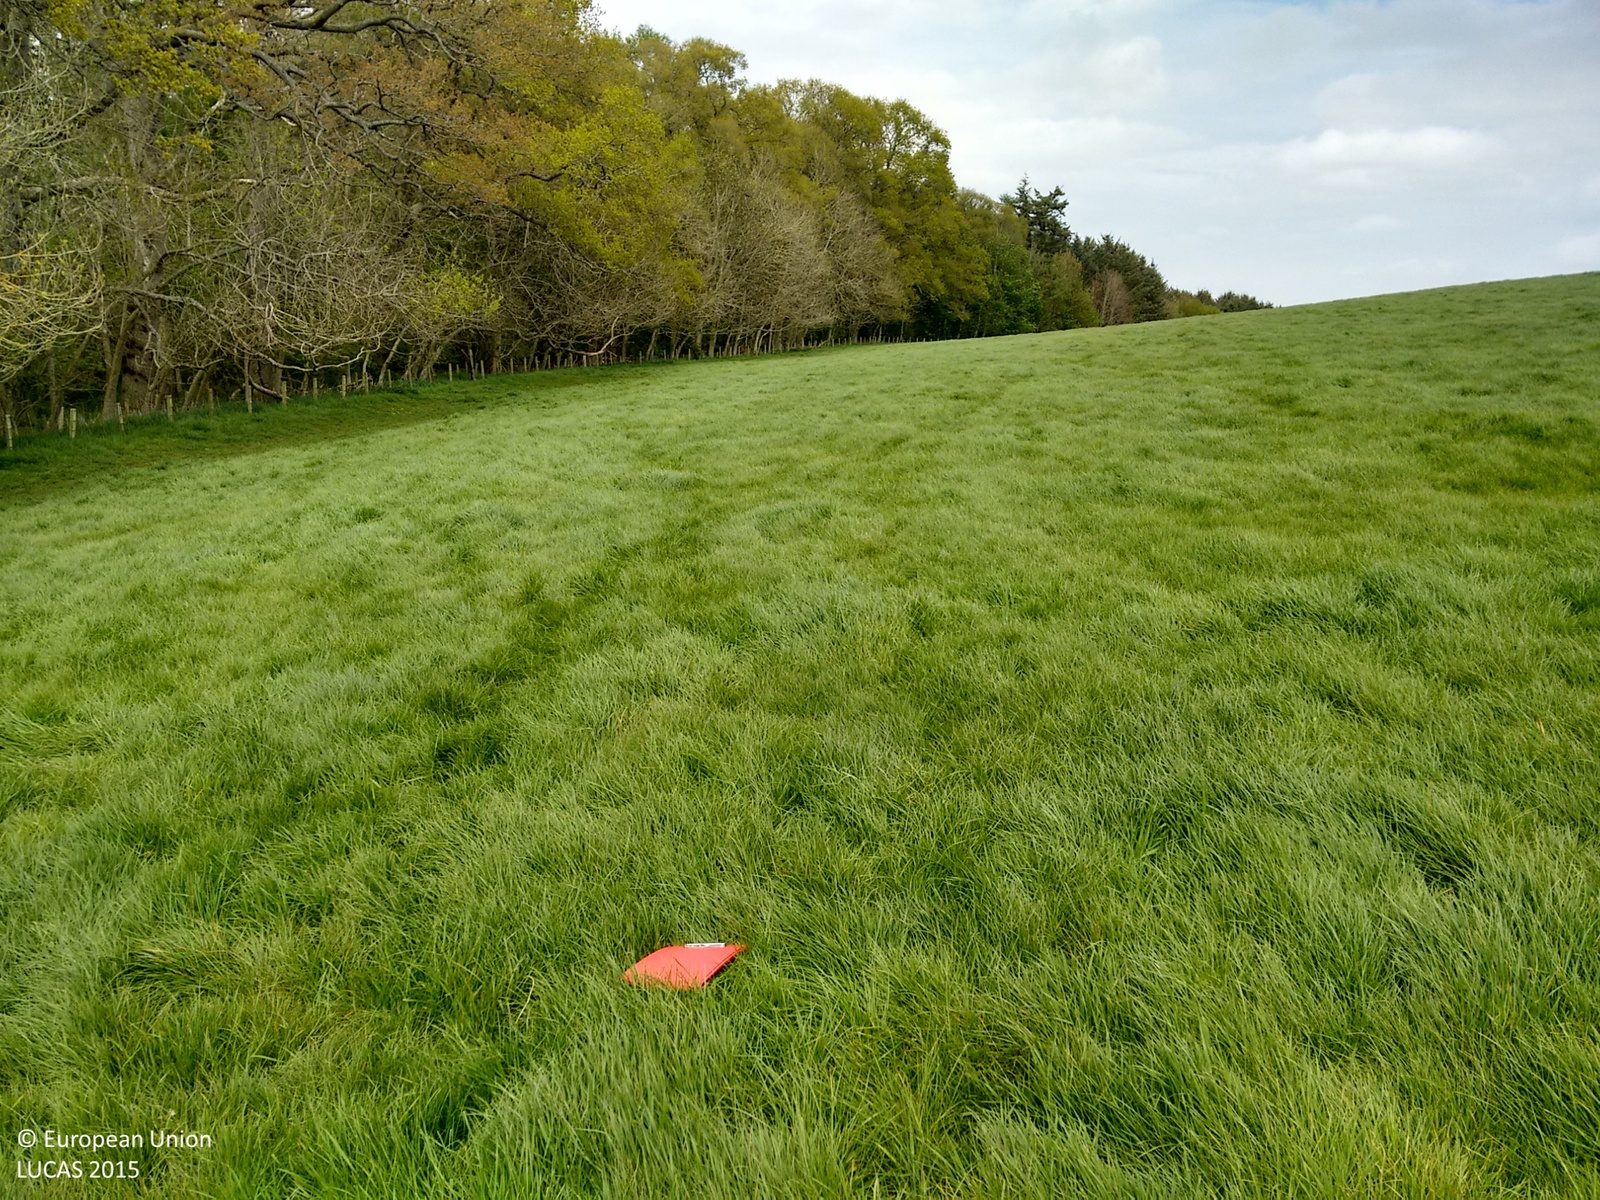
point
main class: Grassland
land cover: Grassland without tree/shrub cover
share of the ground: > 75 %
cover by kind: herbaceous plants 100 %
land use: Agriculture (excluding fallow land and kitchen gardens)
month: May
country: GB
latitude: 55.6677
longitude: -2.2828
